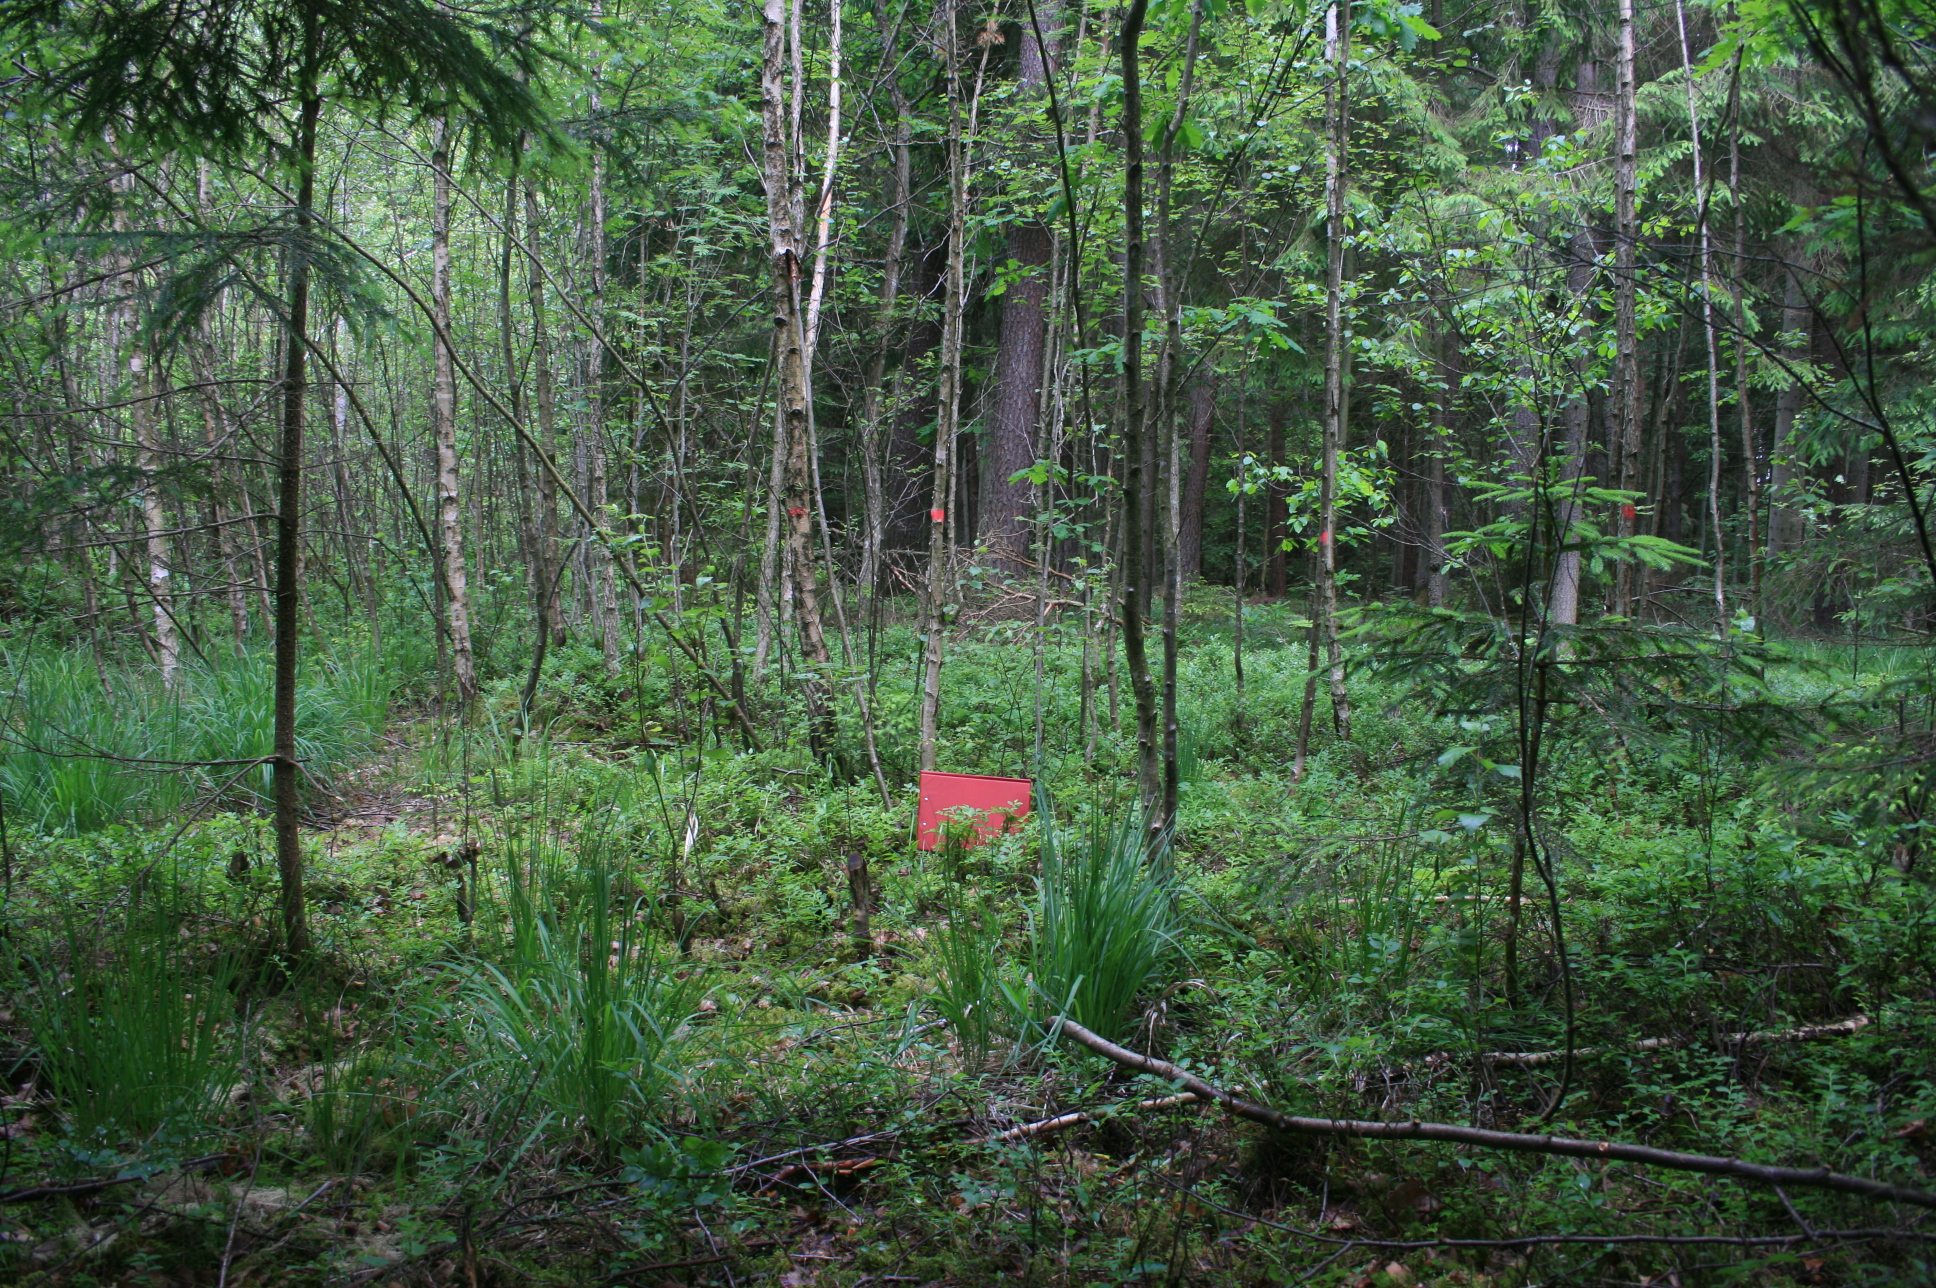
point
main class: Woodland
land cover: Spruce dominated mixed woodland
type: hemiboreal forest and nemoral coniferous forest and mixed broadleaved-coniferous forest
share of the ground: > 75 %
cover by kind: coniferous forest trees 55 %, broadleaved forest trees 30 %, herbaceous plants 15 %
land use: Forestry
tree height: > 5 m
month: June
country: LT
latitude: 55.3375
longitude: 22.3084
